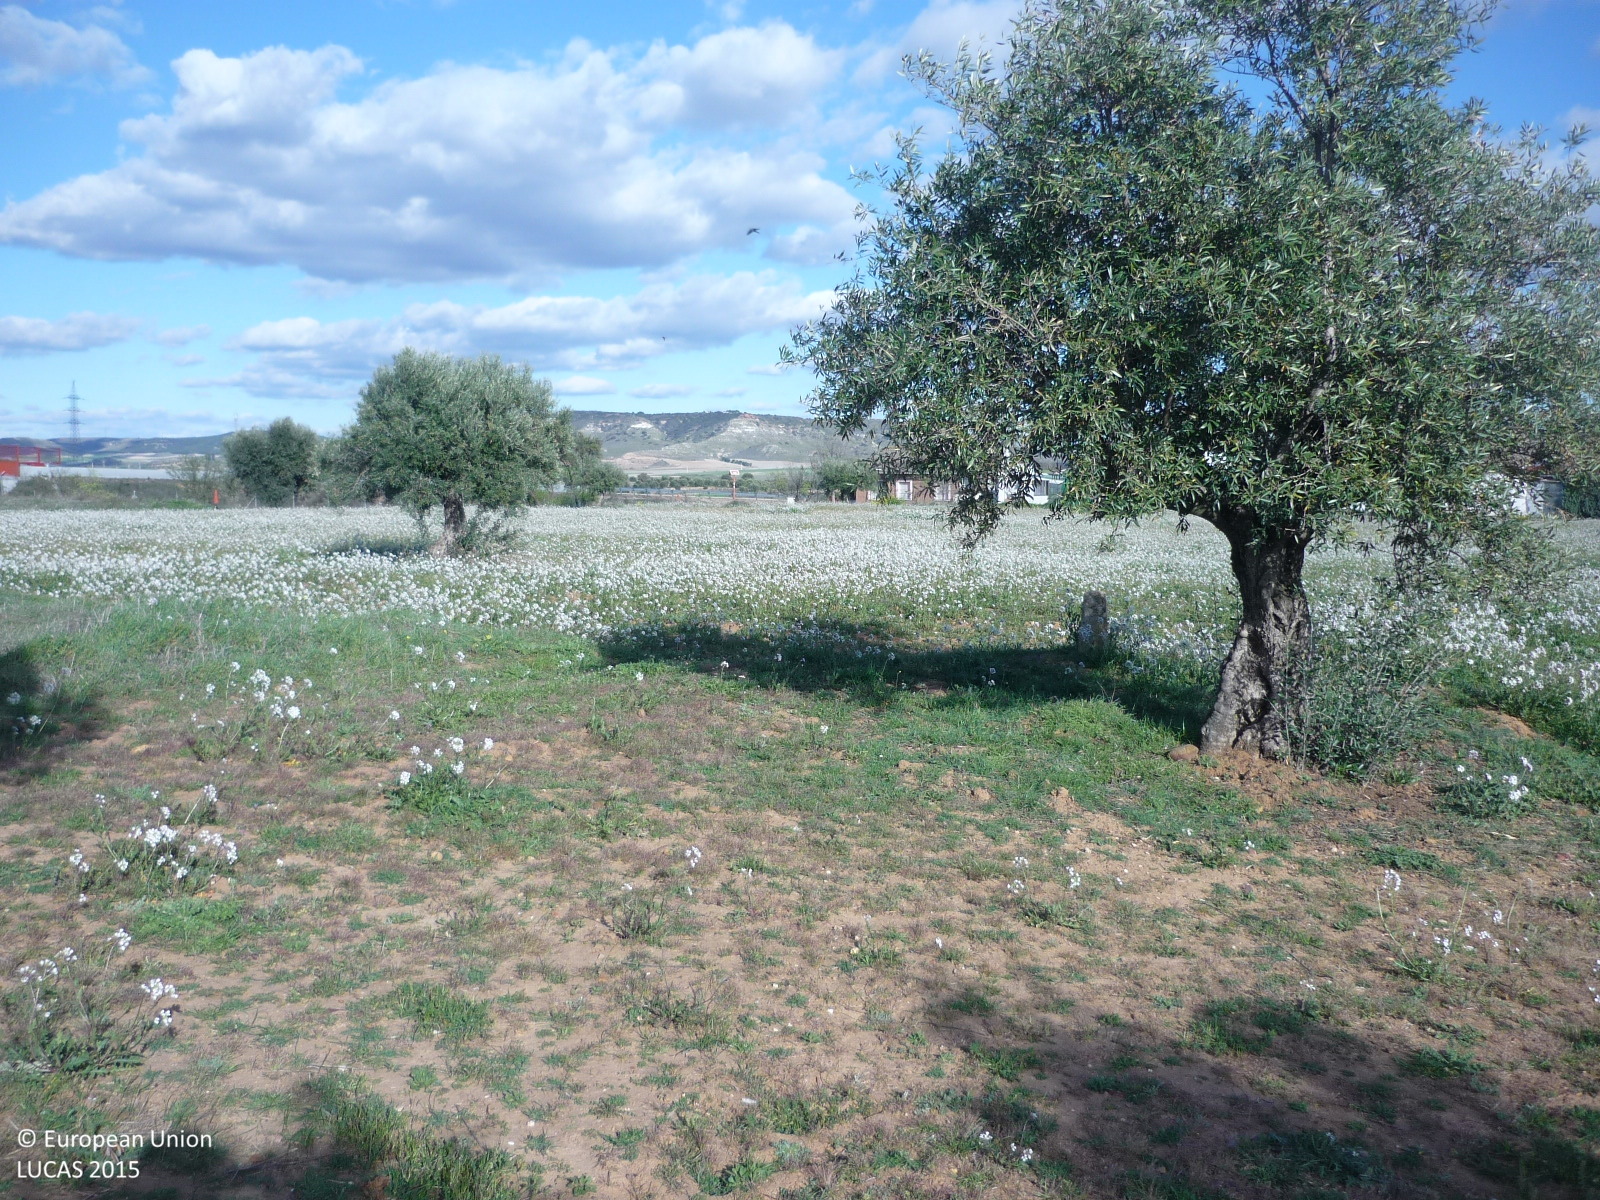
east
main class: Cropland
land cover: Olive groves
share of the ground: 50 - 75 %
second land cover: Grassland without tree/shrub cover
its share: > 75 %
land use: Agriculture (excluding fallow land and kitchen gardens)
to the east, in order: Olive groves; Grassland without tree/shrub cover; Other bare soil; Single bushes/trees; Other bare soil; Nuts trees; Grass margins; Tracks; Fences; Artificial constructions in urban areas; Fences; Grass margins; Sand; Shruby margins; Groves; Fences; Grass margins; Other bare soil; Fences; Grassland without tree/shrub cover; Paved roads, cycling and walking lanes; Grassland without tree/shrub cover; Tracks
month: March
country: ES
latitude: 40.4254
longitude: -3.3879
